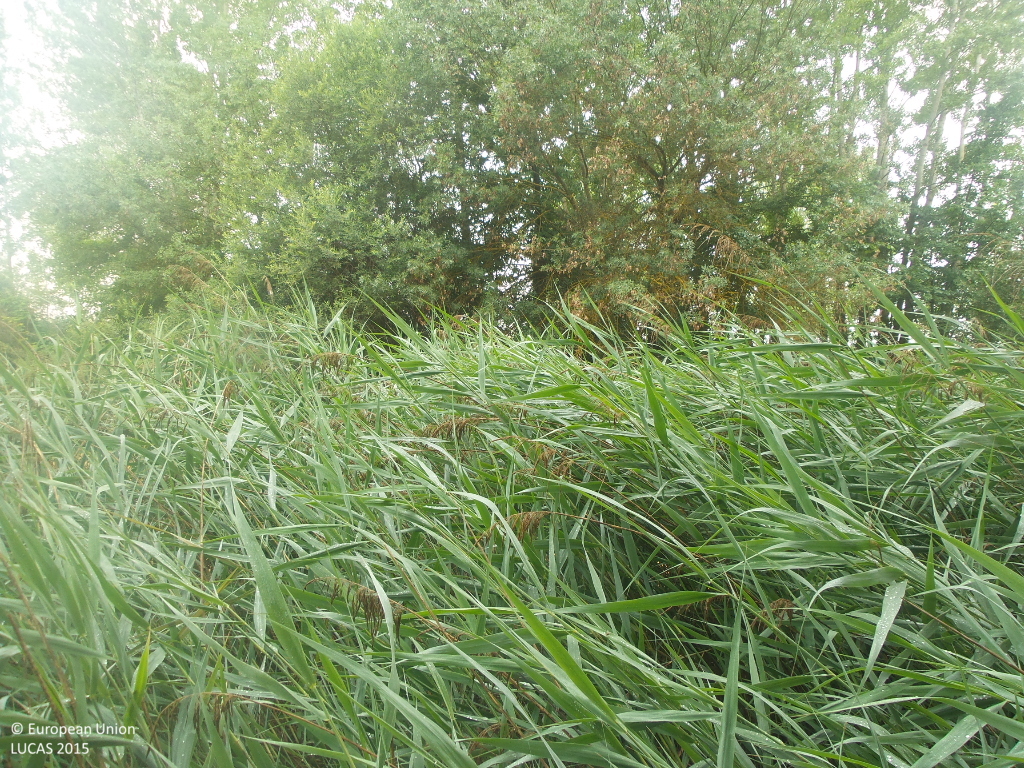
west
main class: Woodland
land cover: Broadleaved woodland
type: floodplain forest
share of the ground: > 75 %
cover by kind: broadleaved forest trees 80 %, shrubs 10 %, herbaceous plants 10 %
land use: Semi-natural and natural areas not in use
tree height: > 5 m
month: June
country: ES
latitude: 41.4978
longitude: -2.7482
